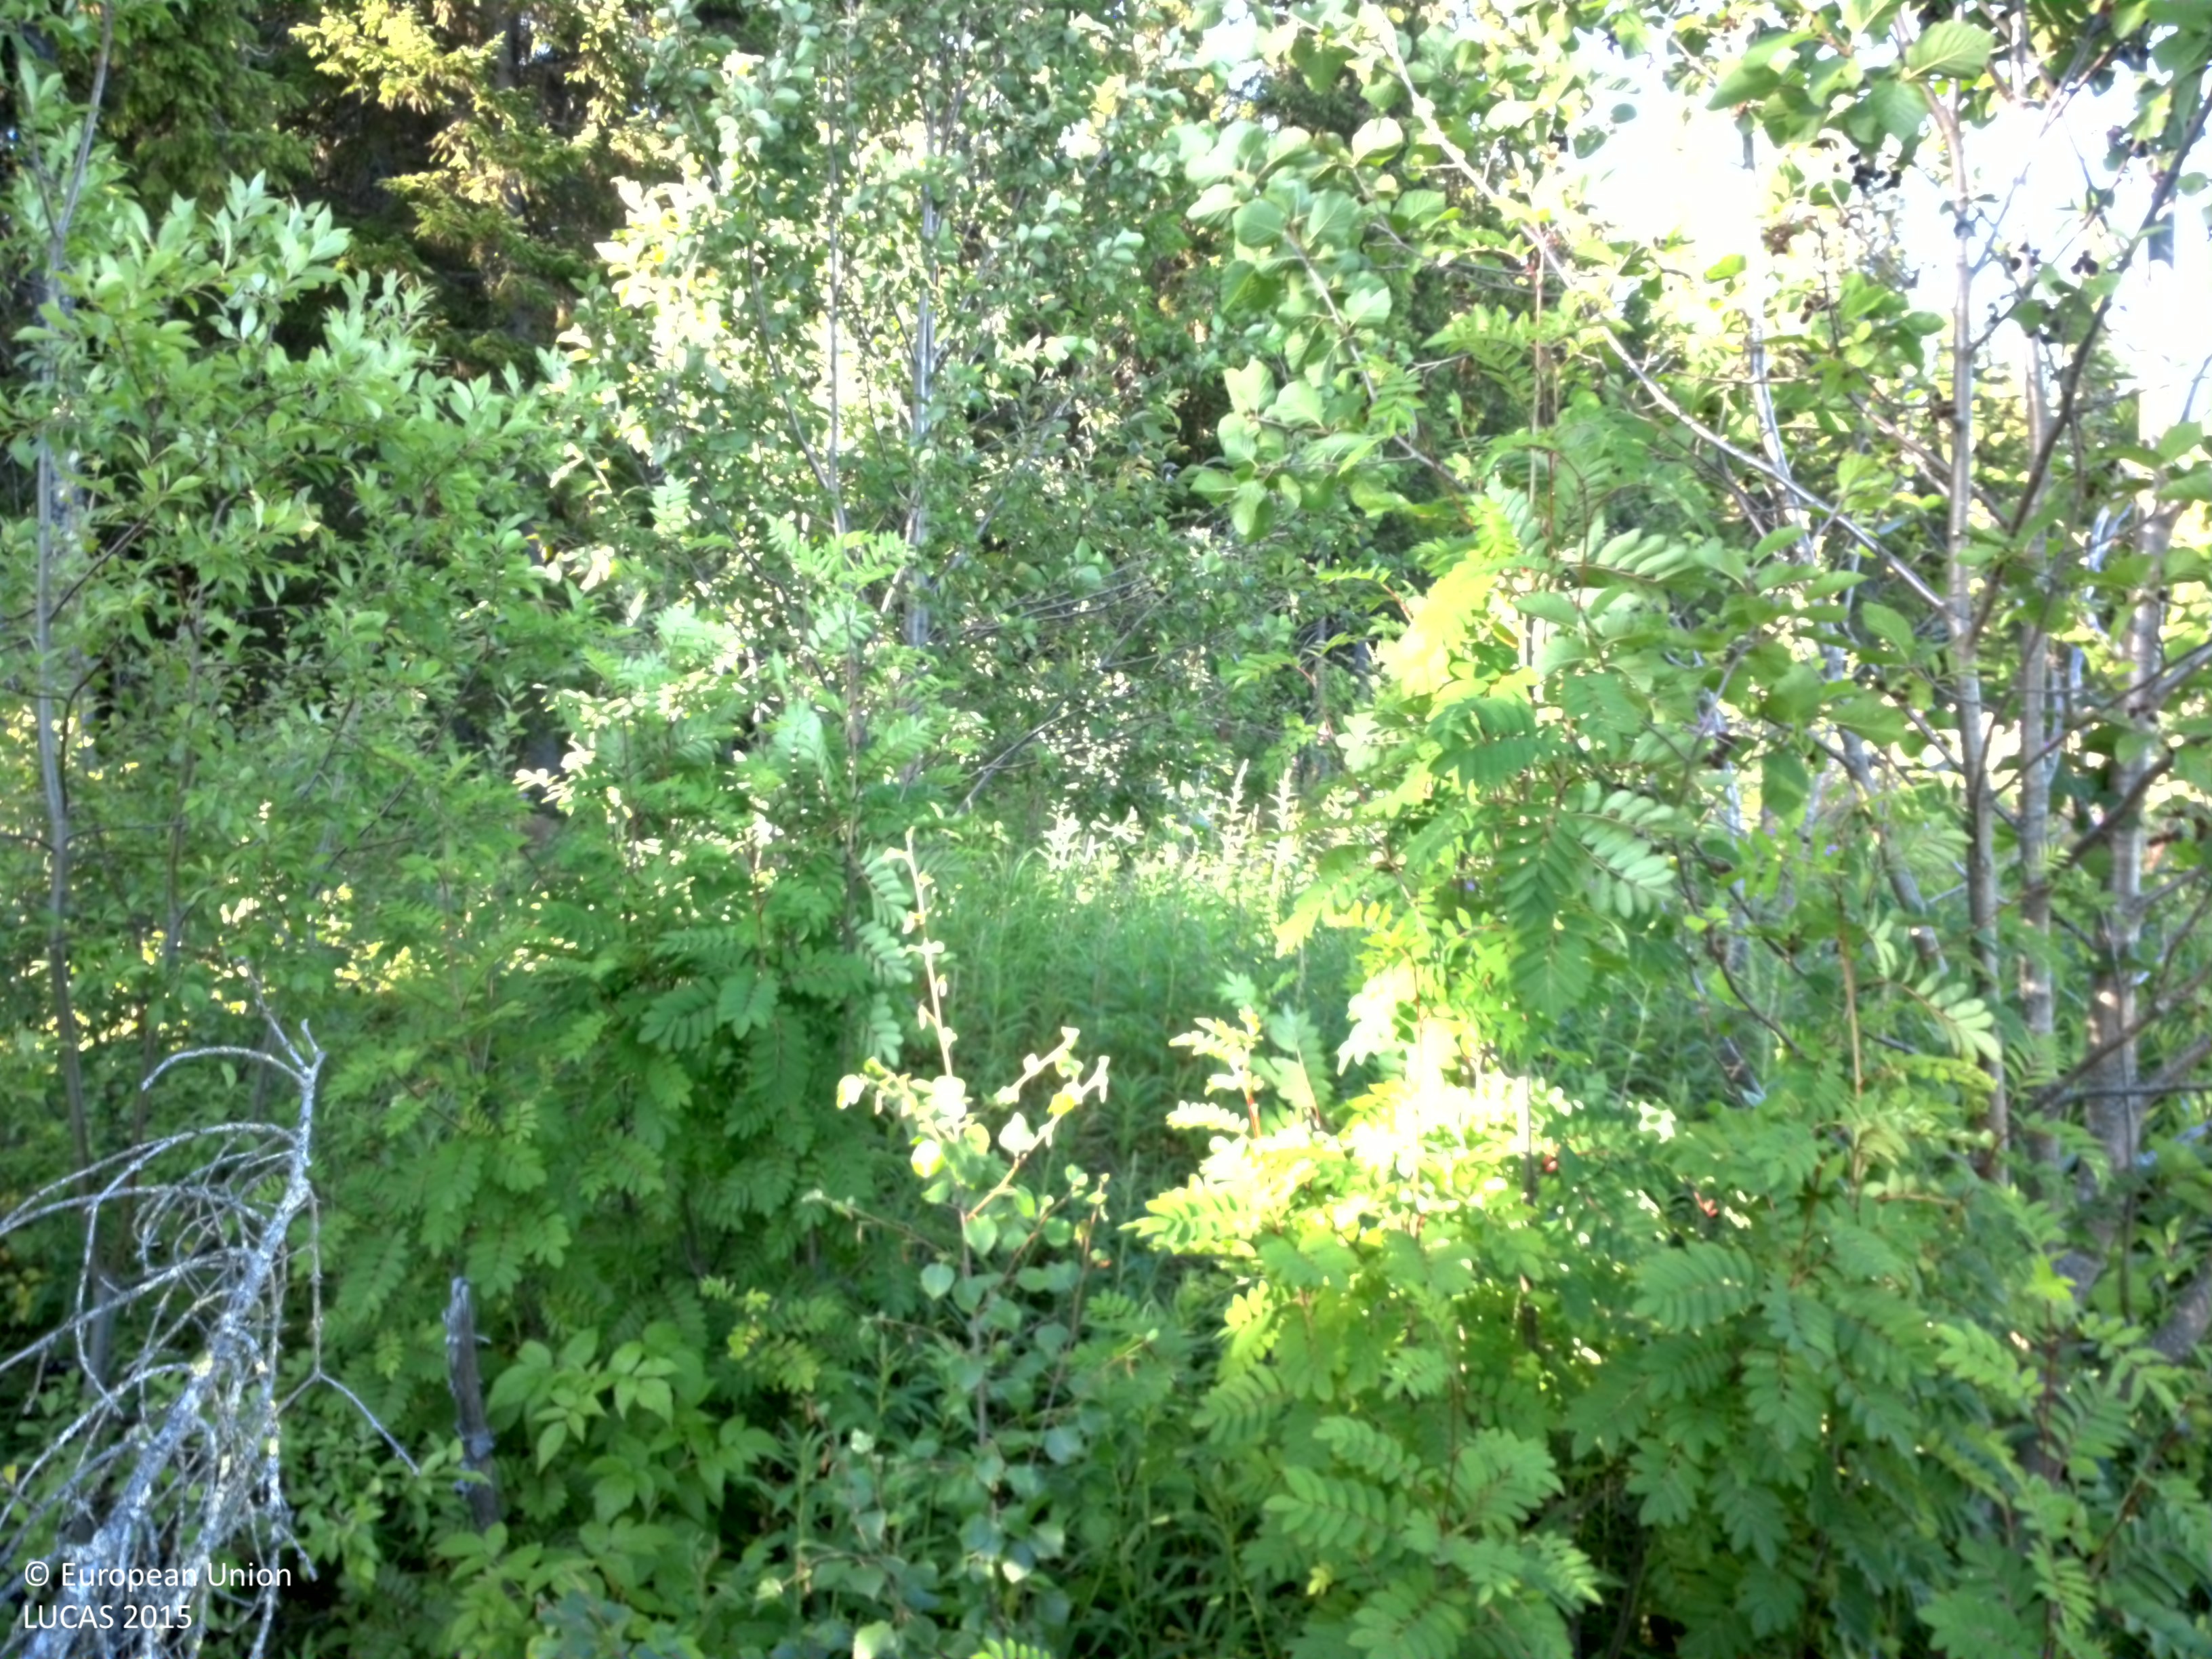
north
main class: Woodland
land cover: Spruce dominated mixed woodland
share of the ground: 10 - 25 %
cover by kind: herbaceous plants 75 %, broadleaved forest trees 10 %, shrubs 10 %, coniferous forest trees 5 %
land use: Forestry
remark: Clear cut
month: August
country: SE
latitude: 64.6972
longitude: 16.1115
